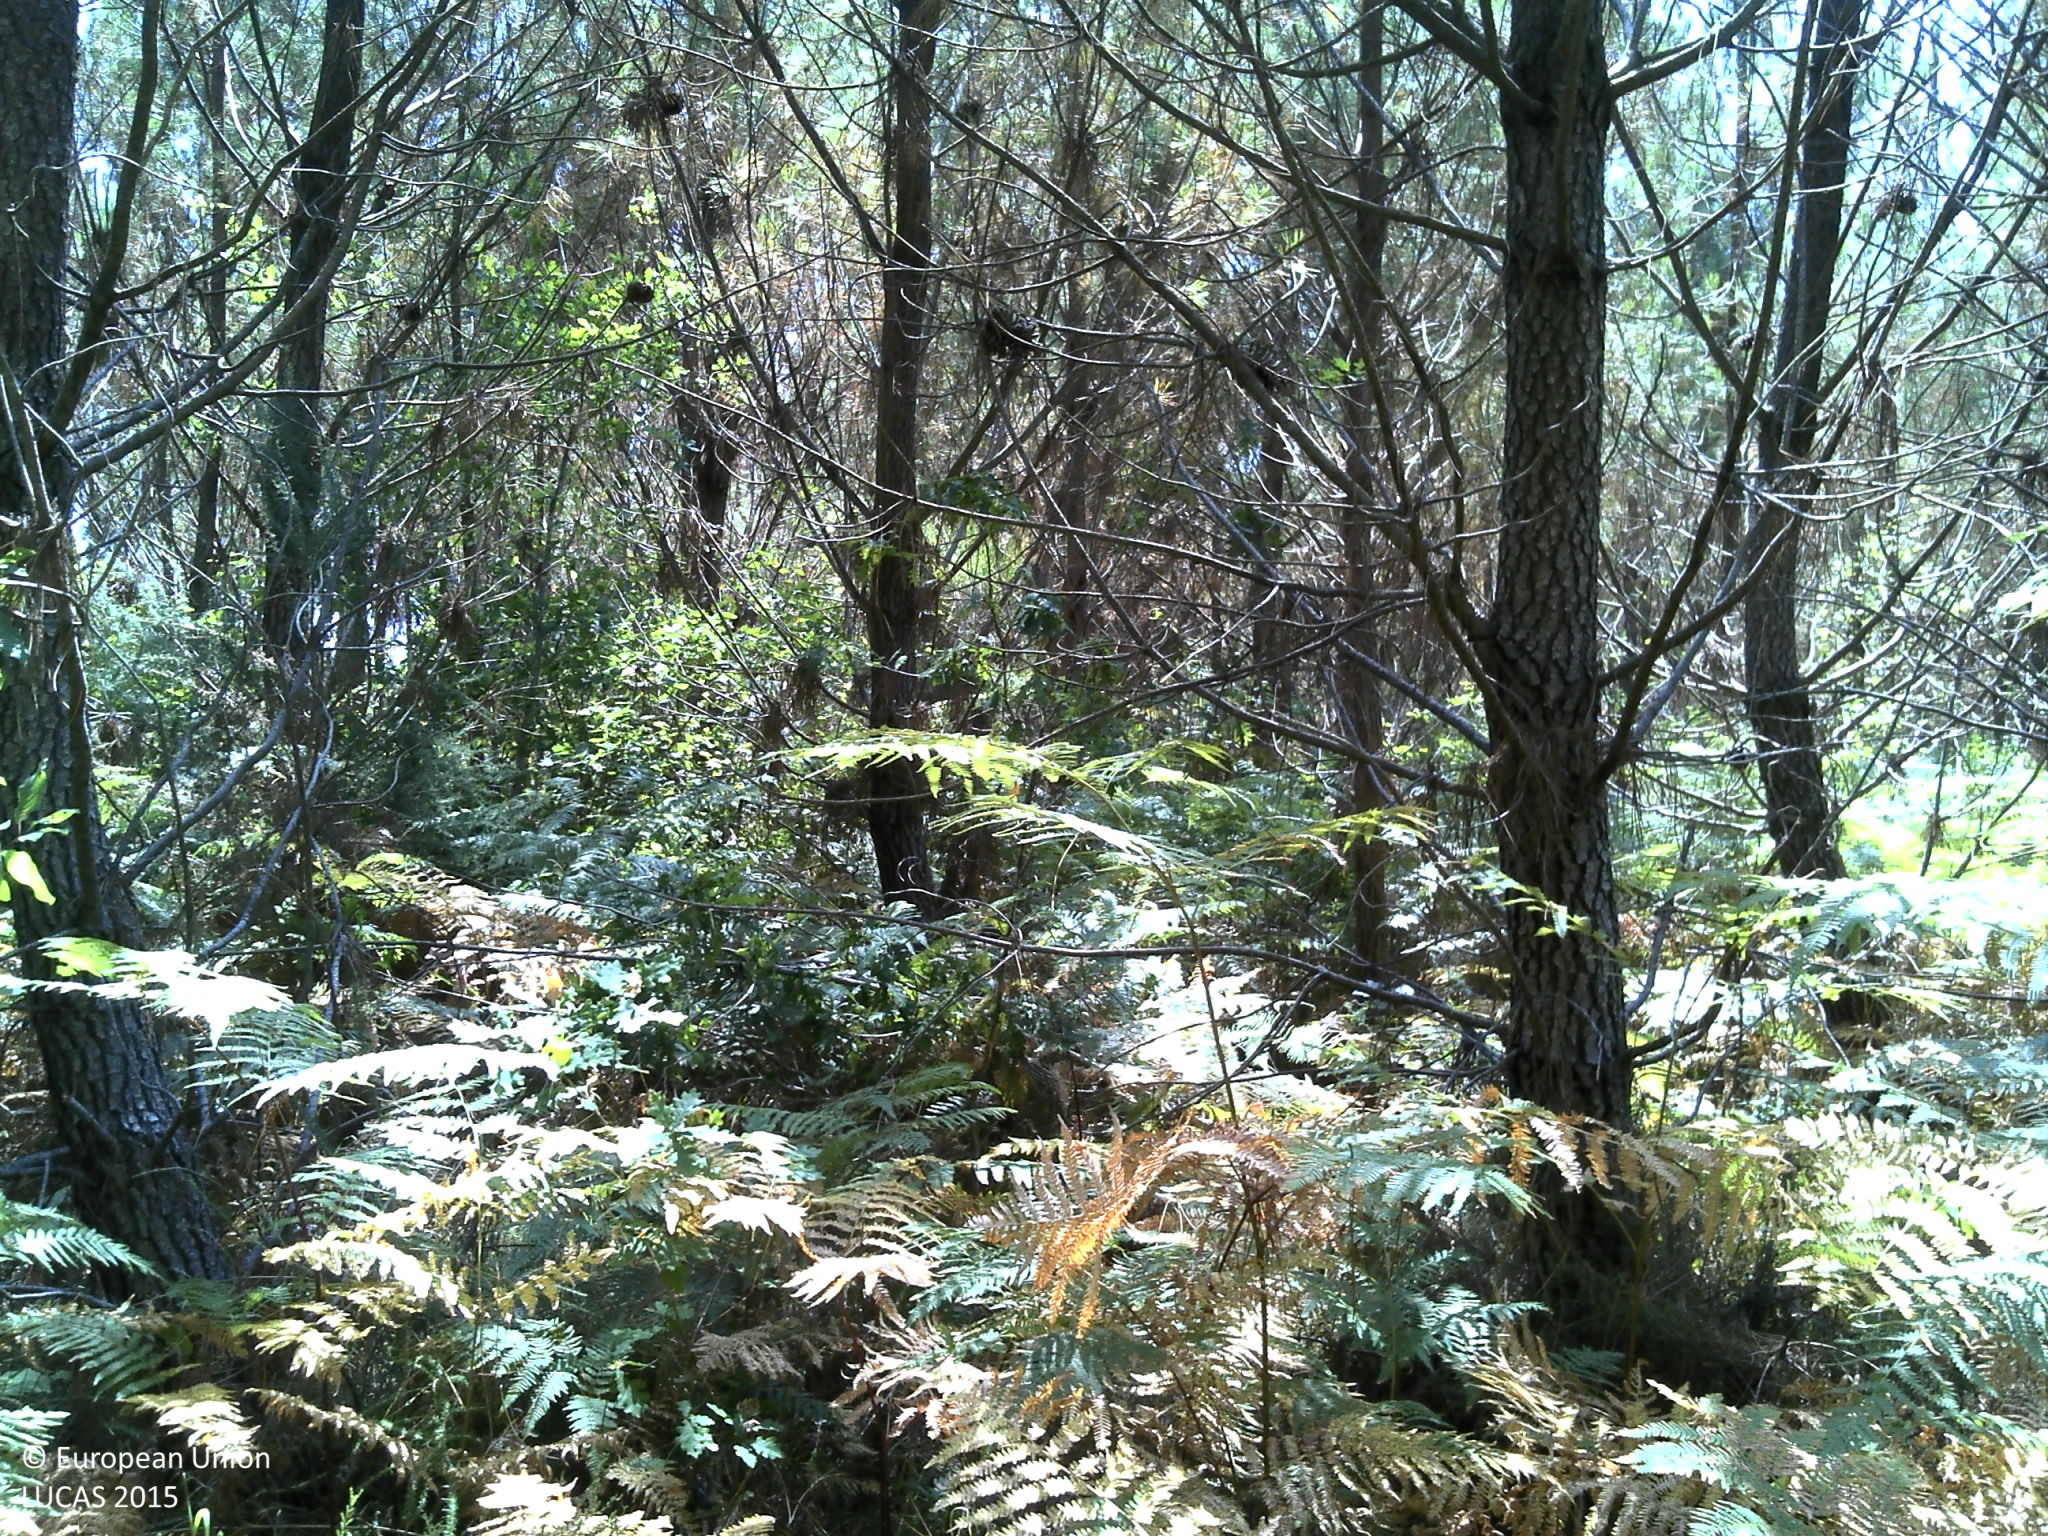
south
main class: Woodland
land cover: Pine dominated coniferous woodland
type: coniferous forest of the mediterranean region
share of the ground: > 75 %
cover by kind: coniferous forest trees 60 %, shrubs 30 %, herbaceous plants 5 %, lichens and mosses 5 %
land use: Forestry
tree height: > 5 m
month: August
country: FR
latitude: 44.9830
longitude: -0.9935
